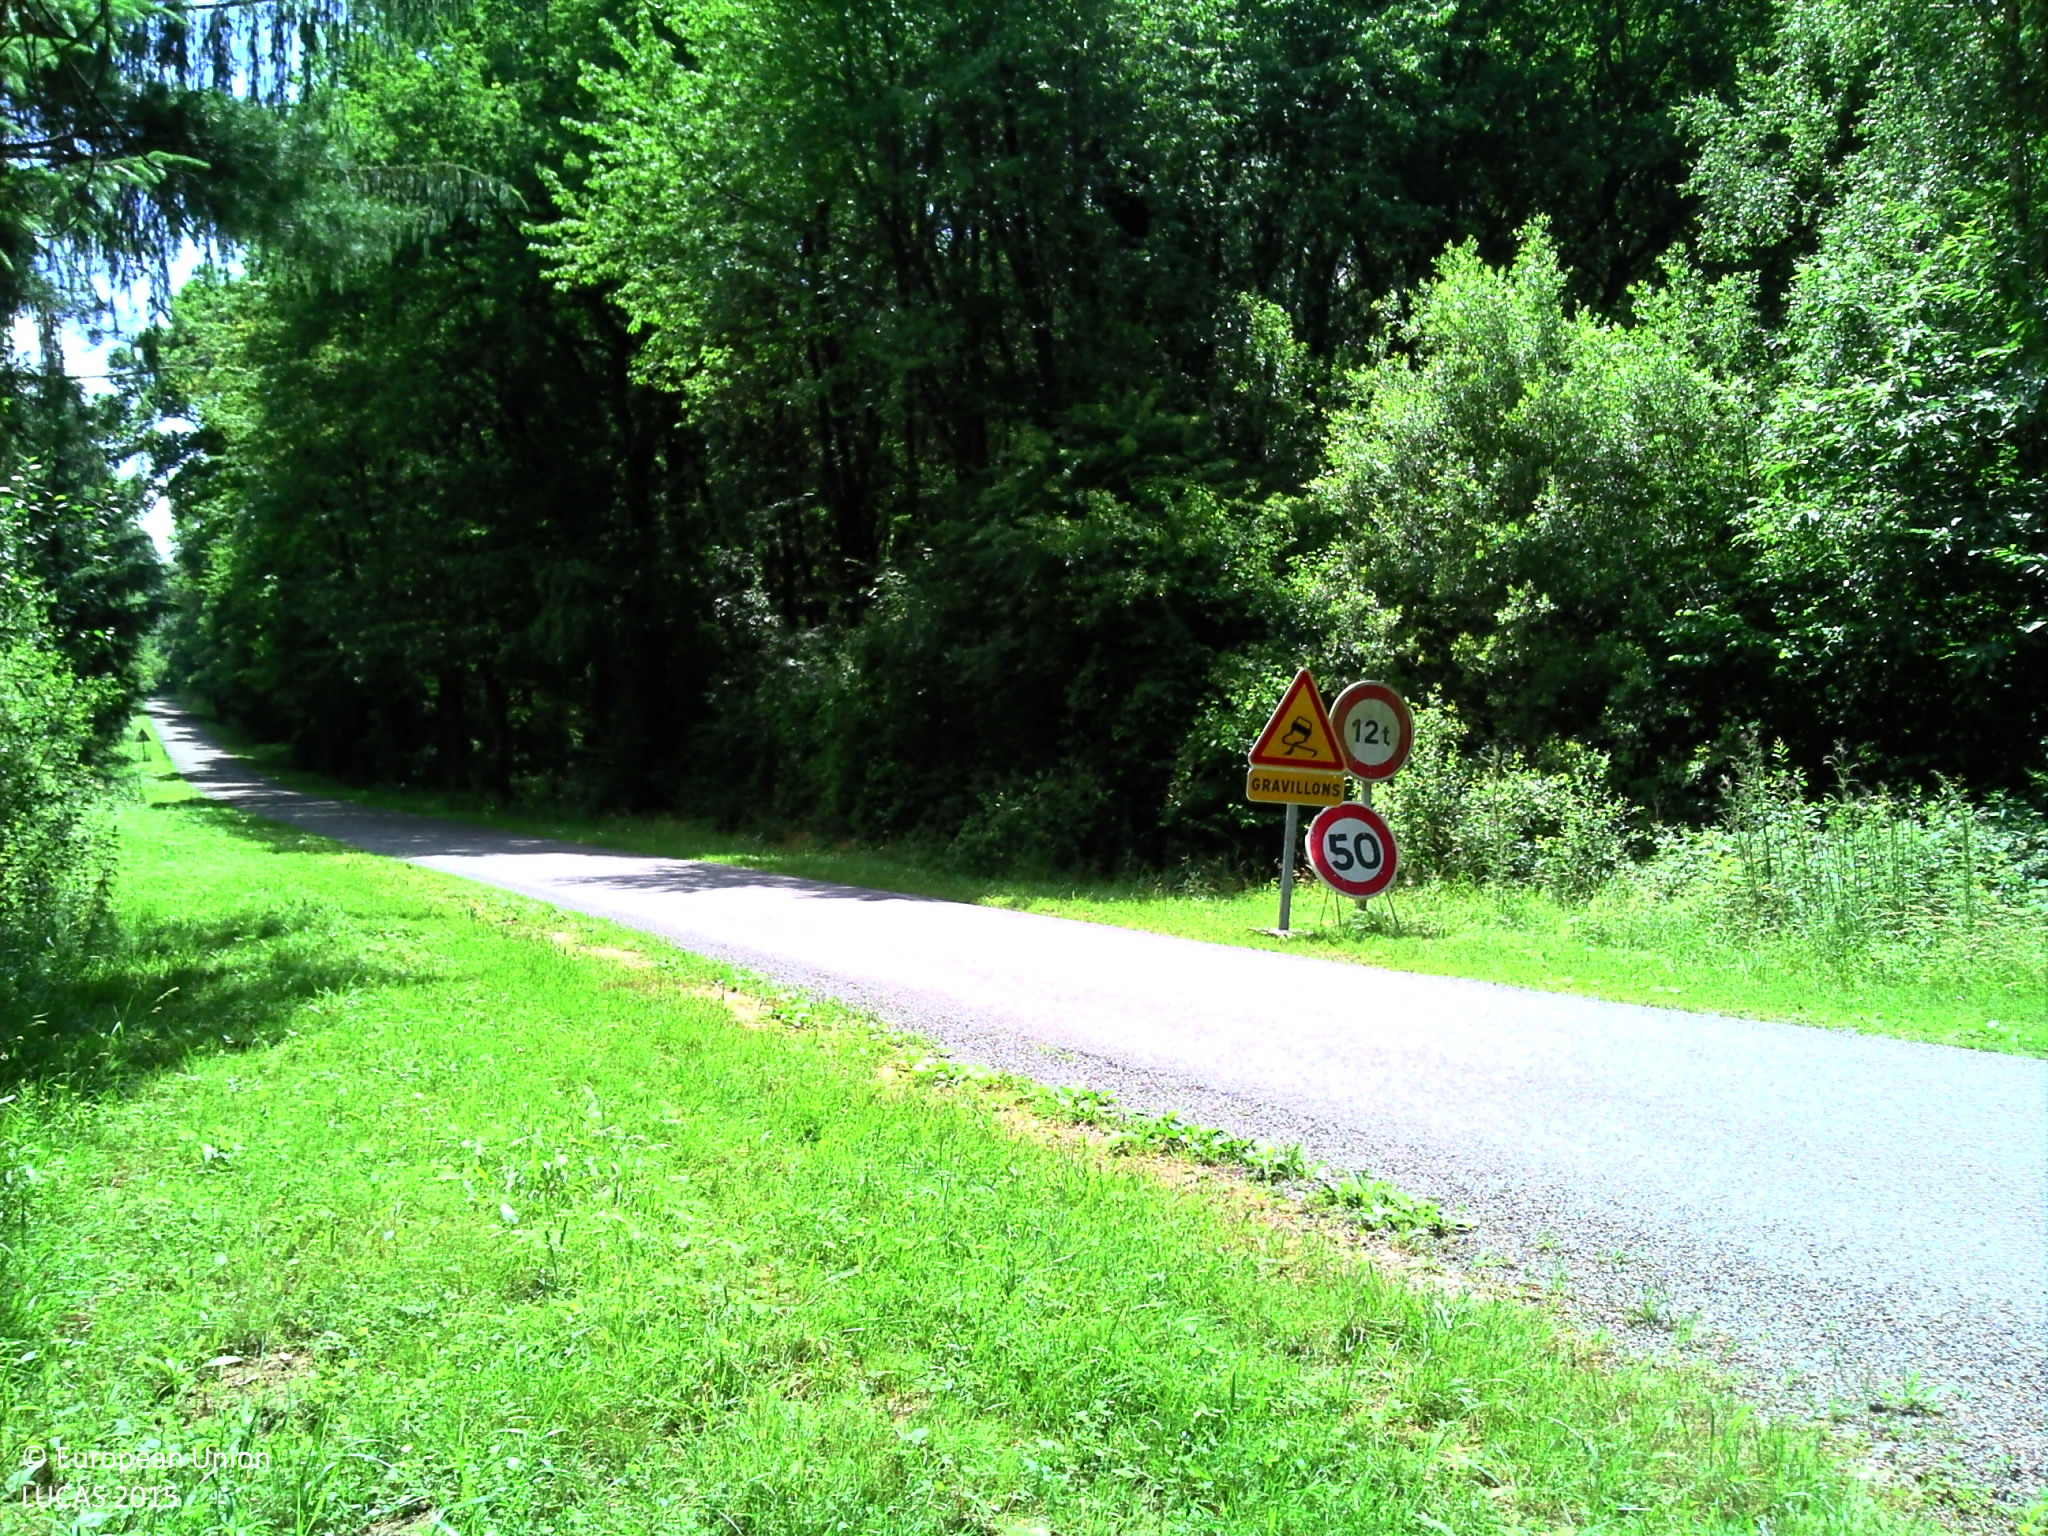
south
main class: Woodland
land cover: Pine dominated mixed woodland
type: acidophilous oak and oak-birch forest
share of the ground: > 75 %
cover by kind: broadleaved forest trees 60 %, coniferous forest trees 25 %, shrubs 10 %, herbaceous plants 5 %
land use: Forestry
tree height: > 5 m
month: June
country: FR
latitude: 46.1787
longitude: 3.0419
